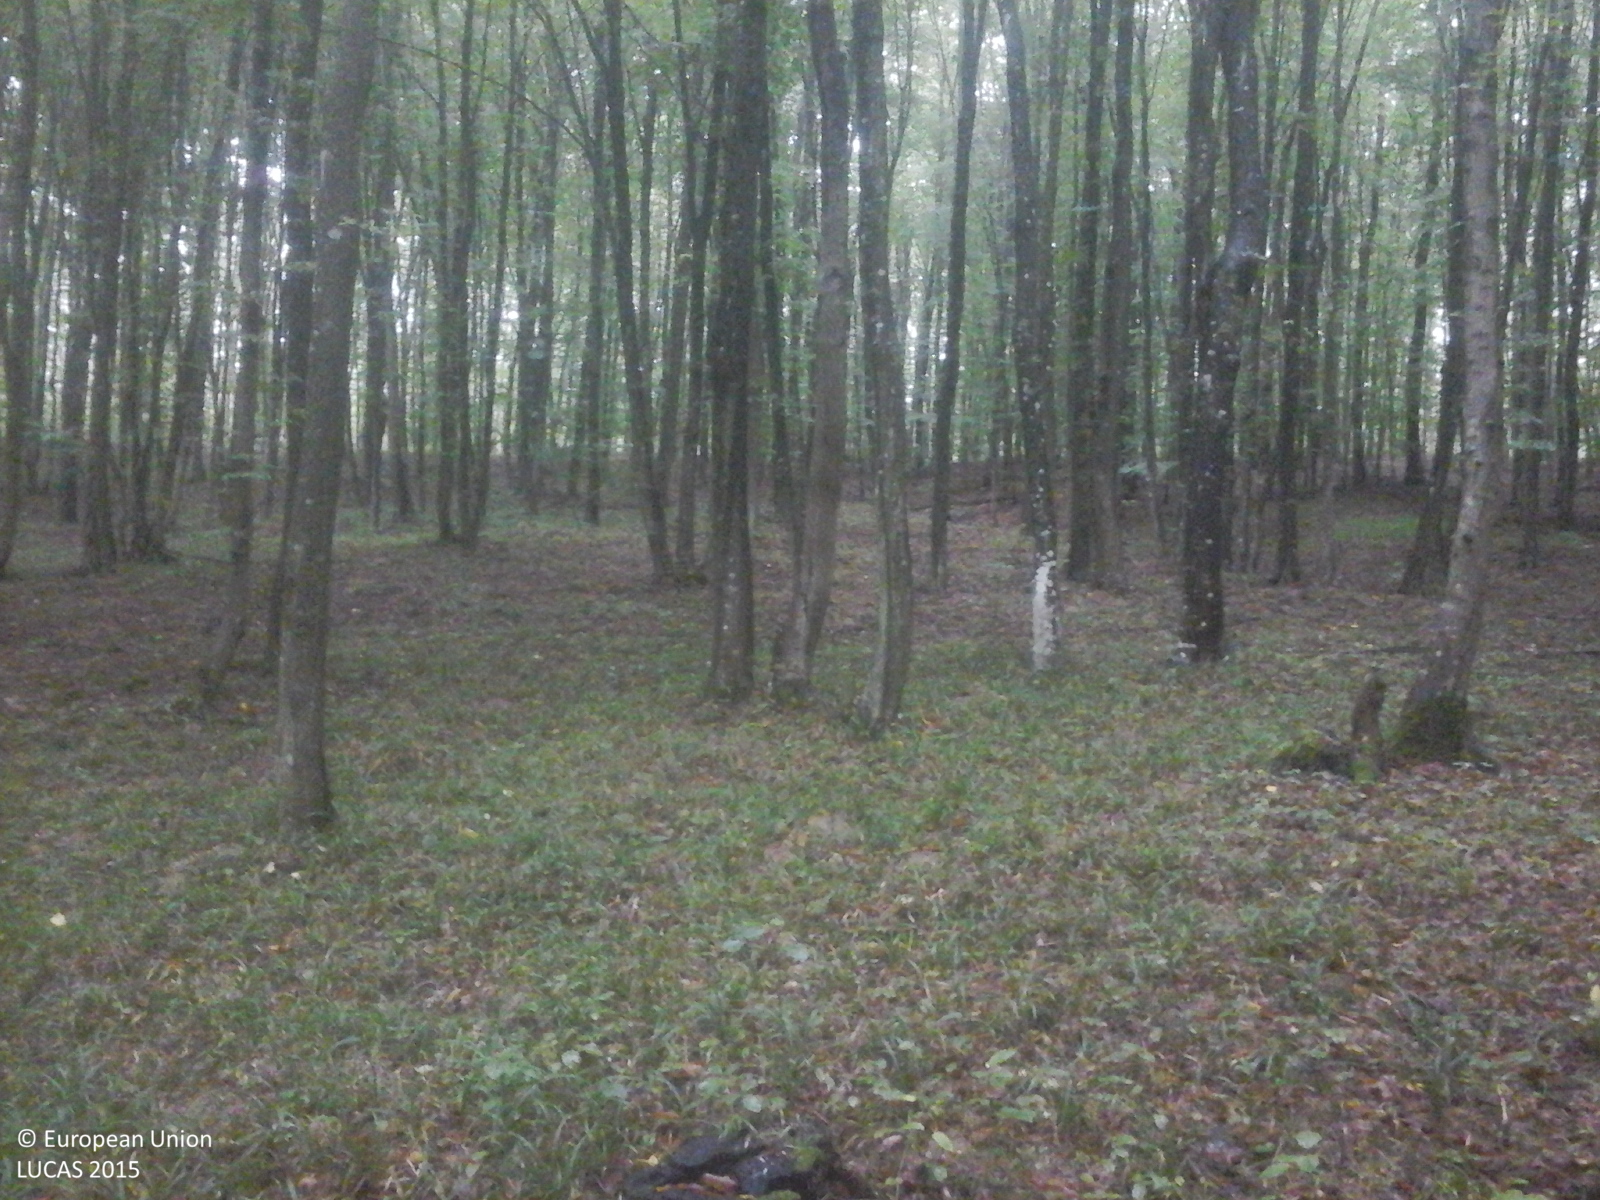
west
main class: Woodland
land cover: Broadleaved woodland
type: mesophytic deciduous forest
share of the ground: > 75 %
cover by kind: broadleaved forest trees 100 %
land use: Forestry
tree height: > 5 m
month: September
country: RO
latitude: 46.8505
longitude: 22.0468
